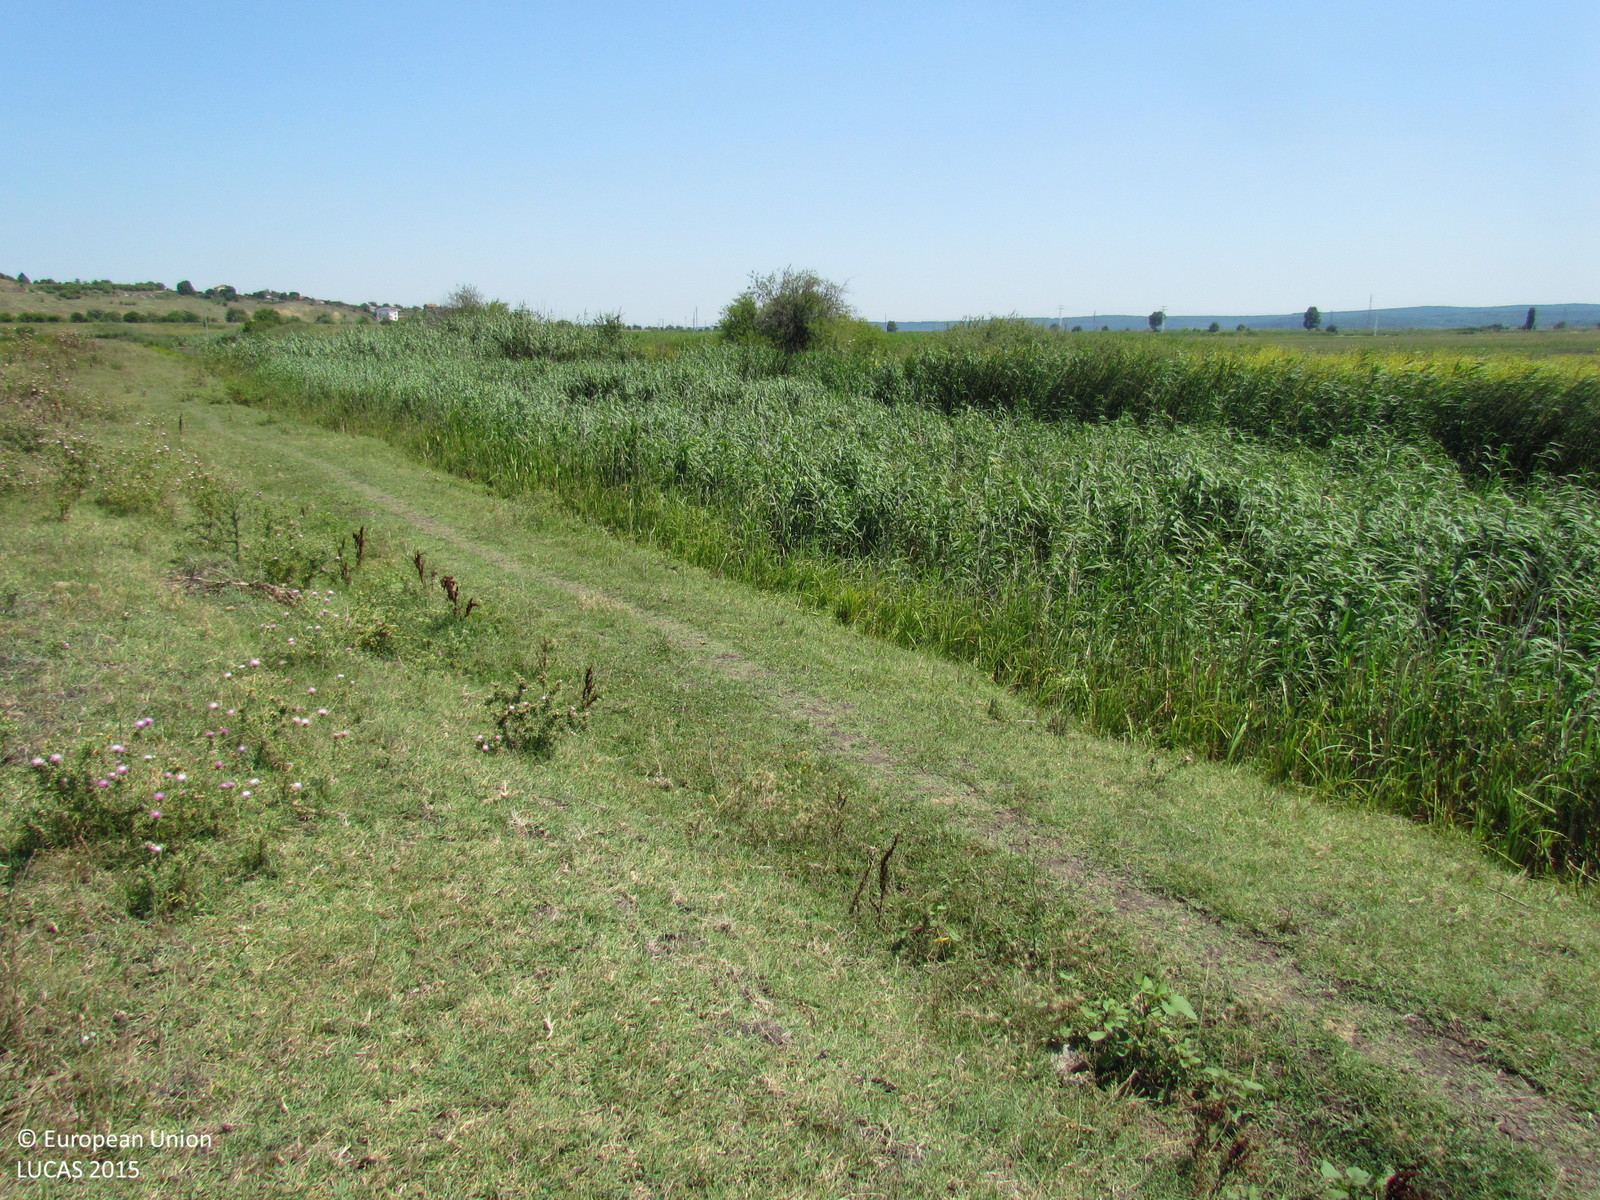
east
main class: Grassland
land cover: Spontaneously vegetated surfaces
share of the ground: > 75 %
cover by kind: herbaceous plants 100 %
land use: Fallow land
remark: Temporary flooded
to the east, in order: Spontaneously vegetated surfaces
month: July
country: BG
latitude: 42.4044
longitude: 27.3035
